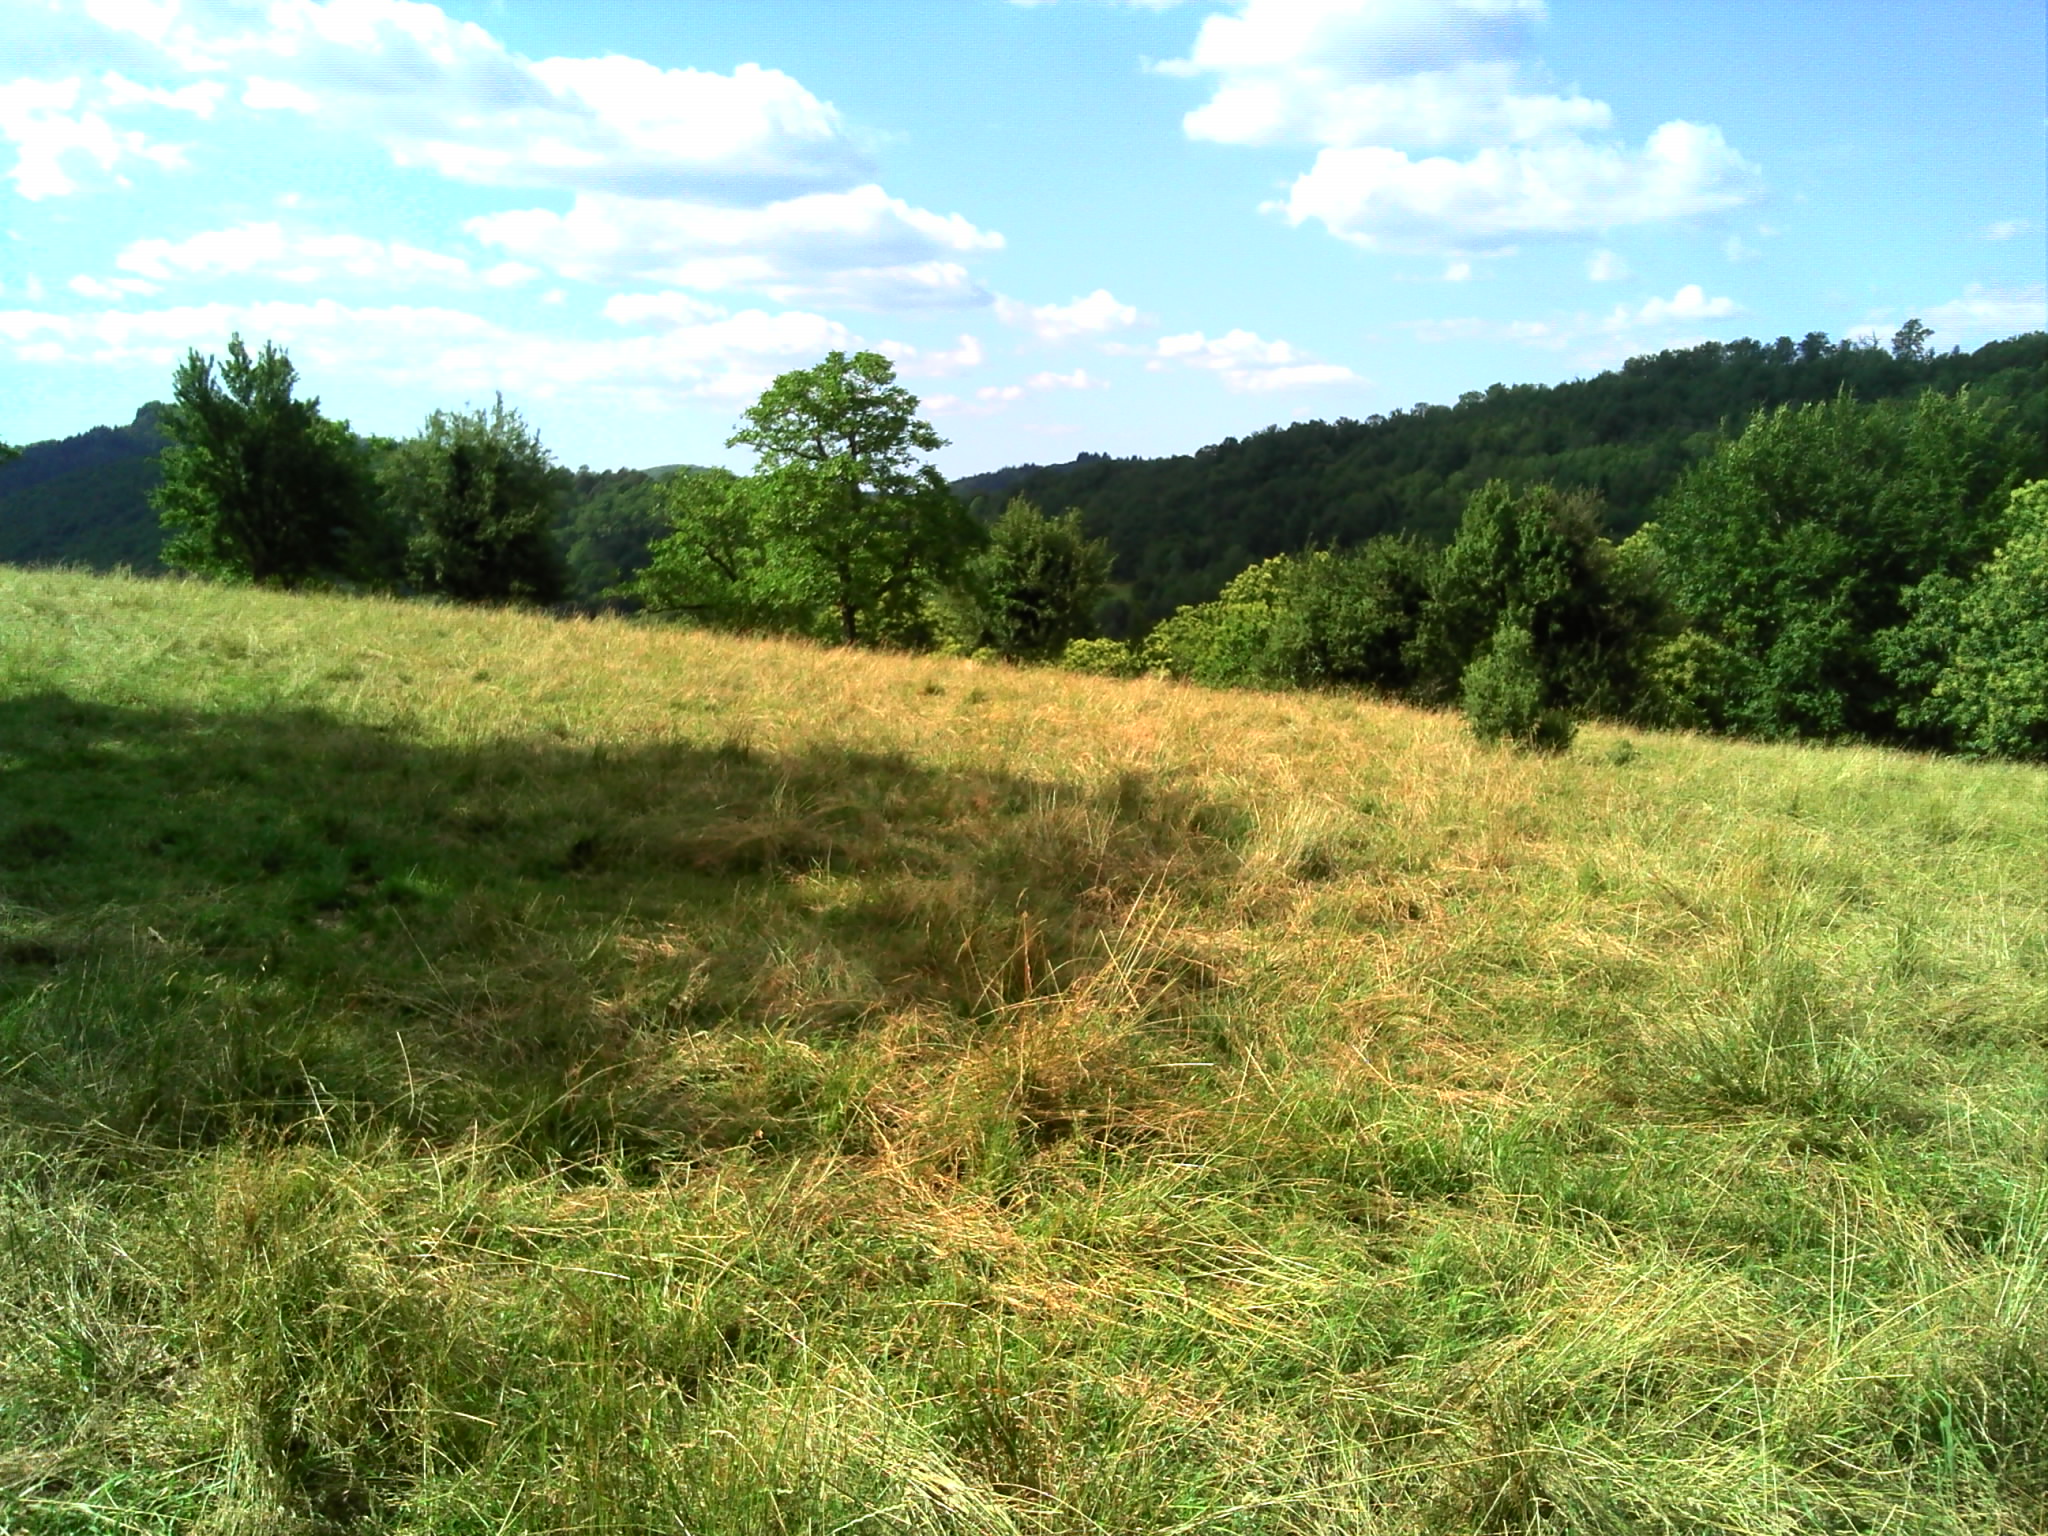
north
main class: Grassland
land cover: Grassland with sparse tree/shrub cover
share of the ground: > 75 %
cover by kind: herbaceous plants 95 %, broadleaved forest trees 5 %
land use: Agriculture (excluding fallow land and kitchen gardens)
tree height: > 5 m
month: June
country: FR
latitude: 44.8895
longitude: 1.9585
